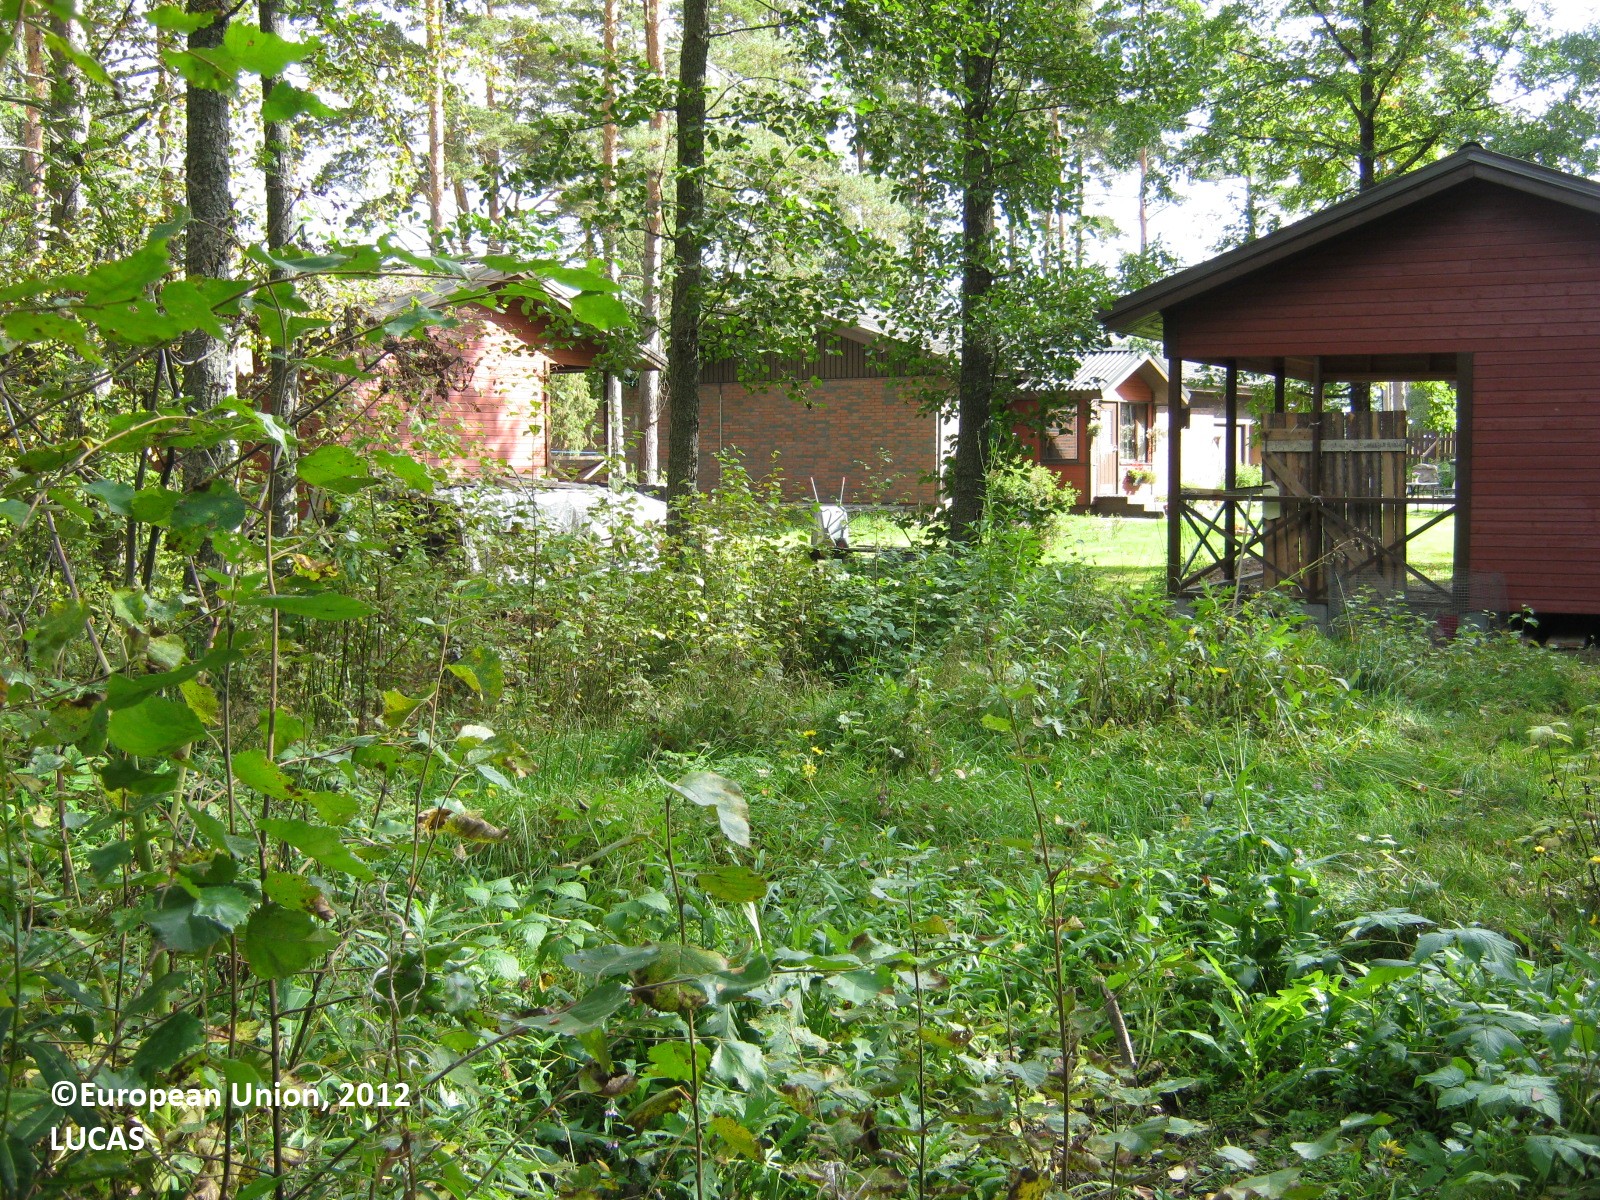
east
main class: Woodland
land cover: Broadleaved woodland
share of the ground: > 75 %
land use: Residential
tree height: > 5 m
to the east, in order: Broadleaved woodland; Artificial constructions in urban areas; Intertidal flats
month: September
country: FI
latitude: 60.5805
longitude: 27.7326
